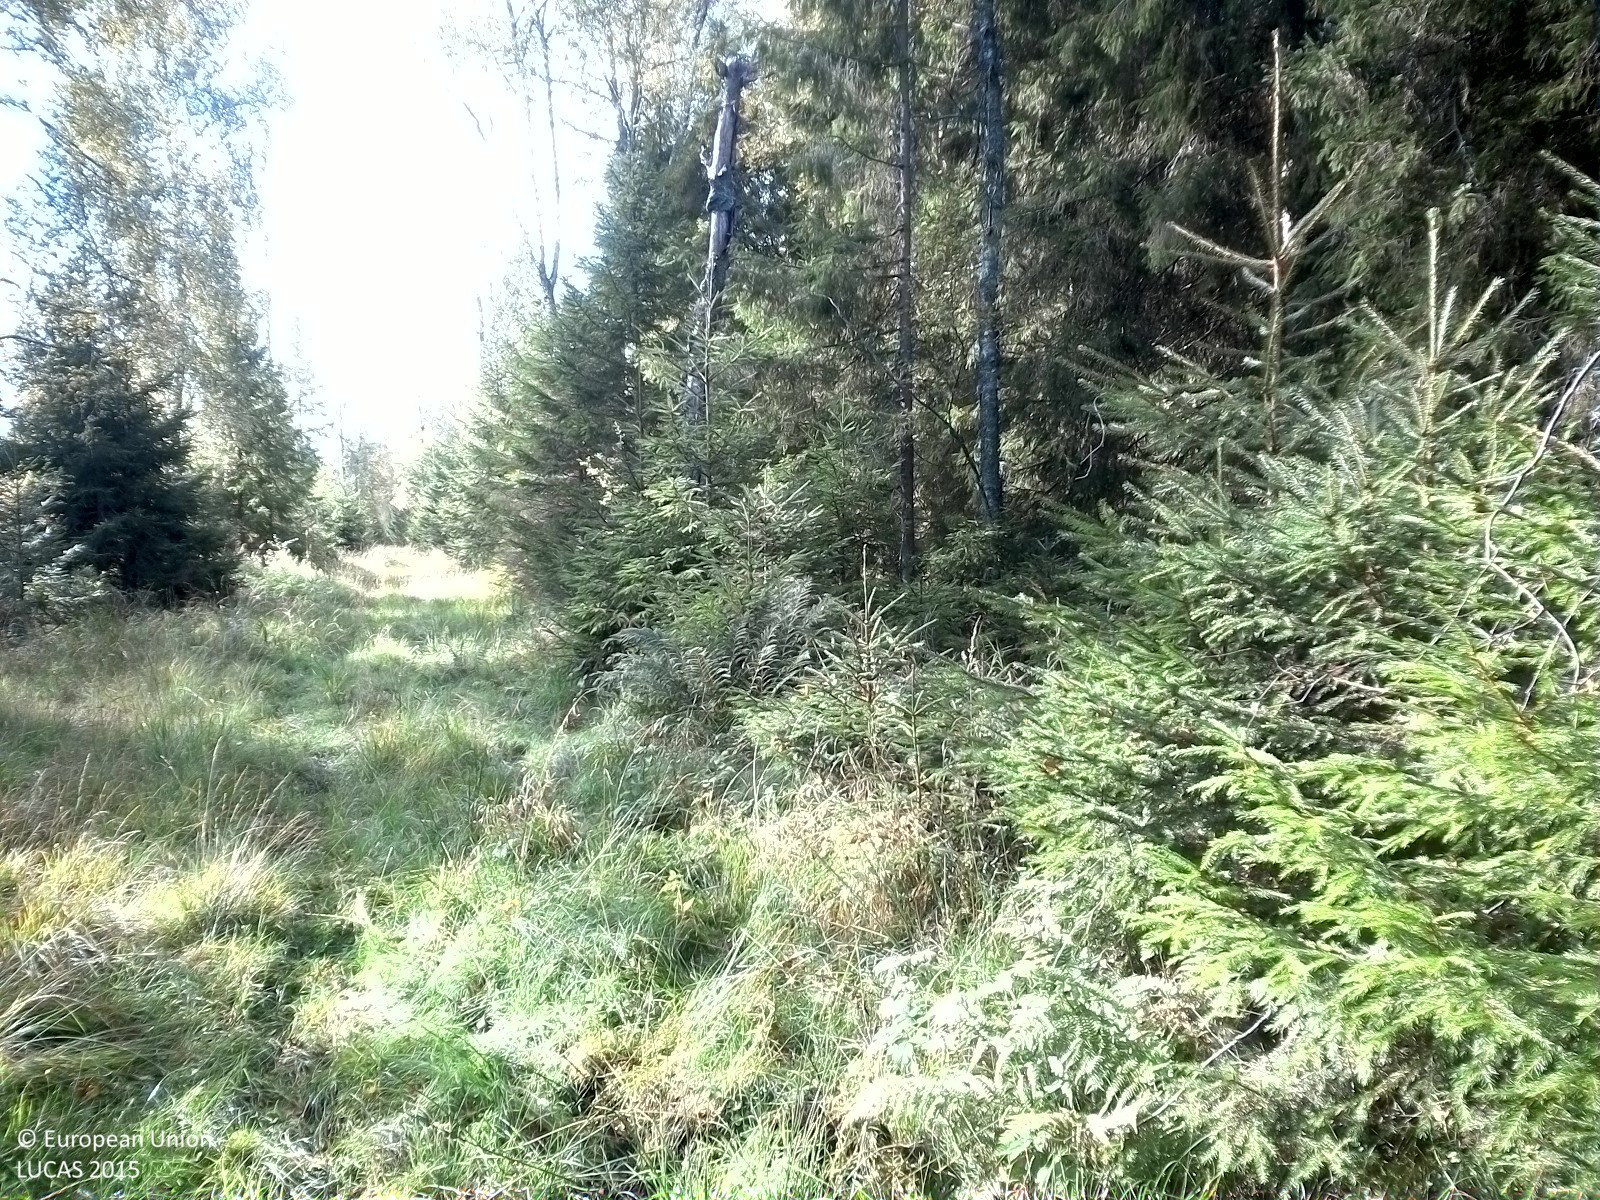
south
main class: Grassland
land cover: Grassland without tree/shrub cover
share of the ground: > 75 %
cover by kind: herbaceous plants 95 %, unconsolidated bare surface 5 %
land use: Amenities, museums, leisure
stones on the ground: < 10 %
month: August
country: SE
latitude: 59.0966
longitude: 15.5610
